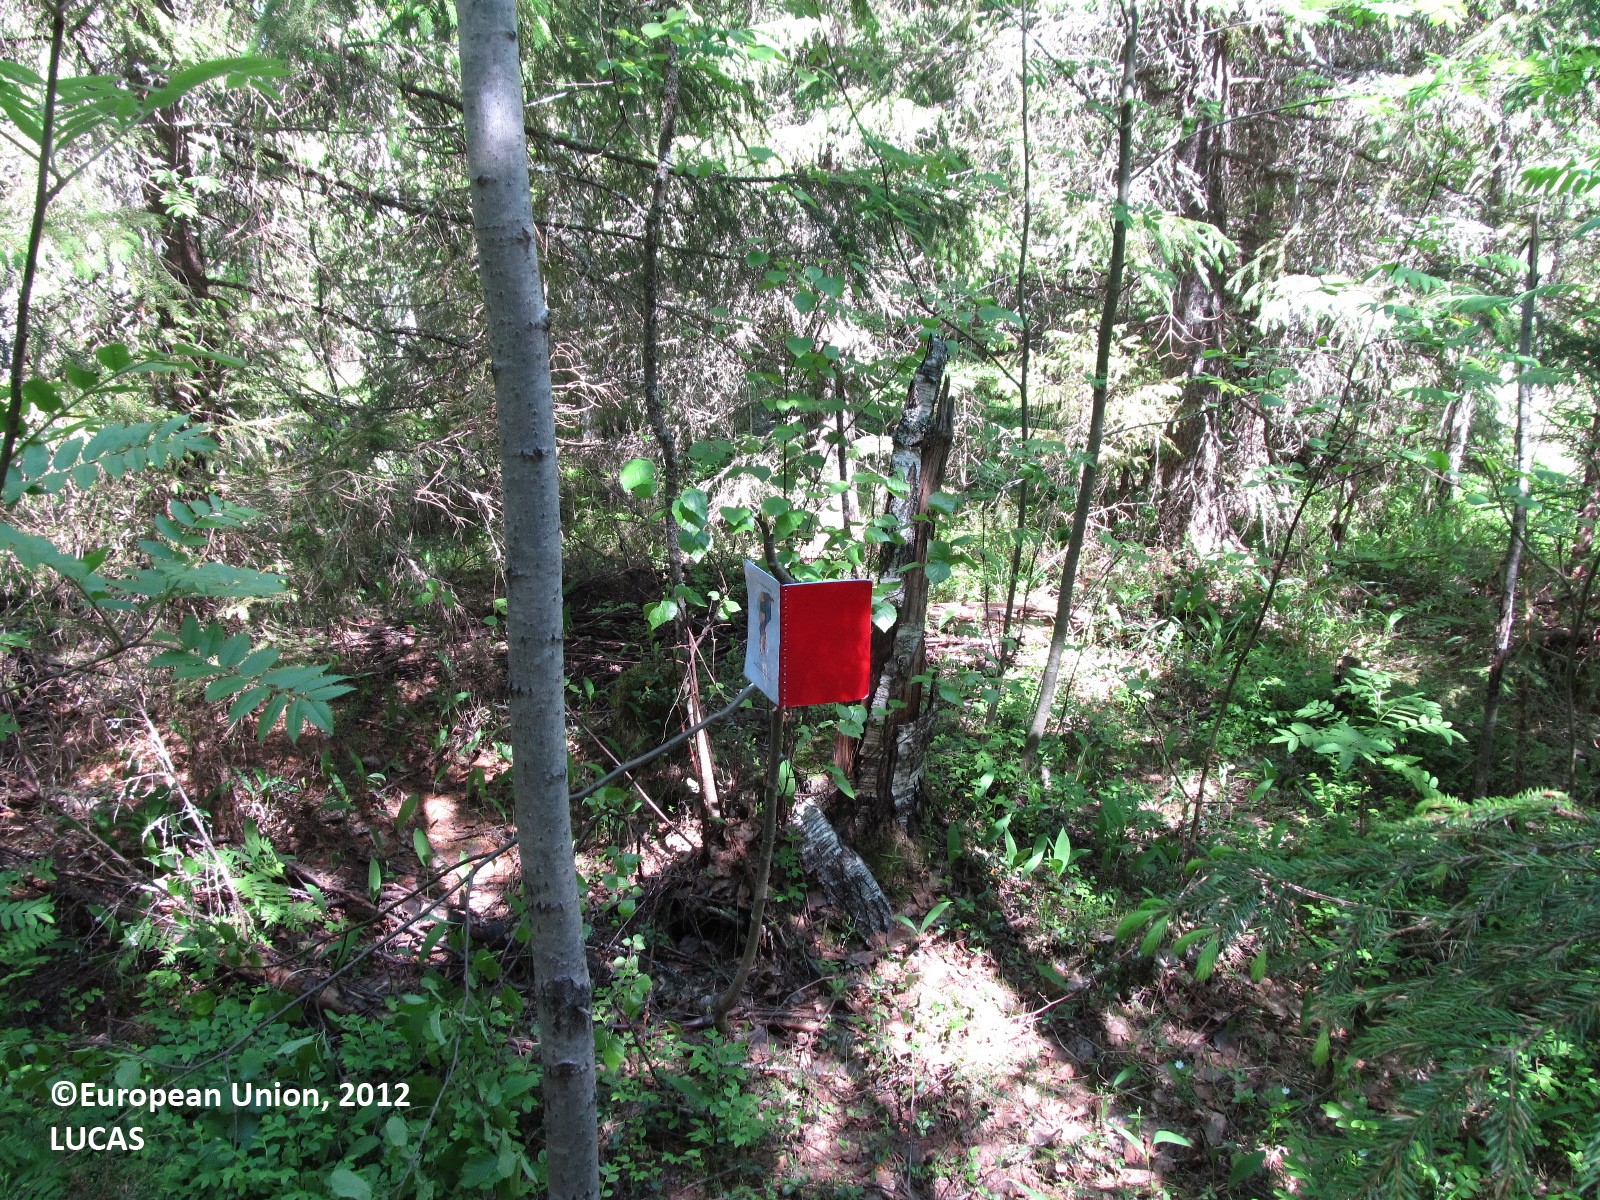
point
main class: Woodland
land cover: Spruce dominated mixed woodland
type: boreal forest
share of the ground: > 75 %
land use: Forestry
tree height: > 5 m
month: June
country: FI
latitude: 62.7197
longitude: 27.3907
